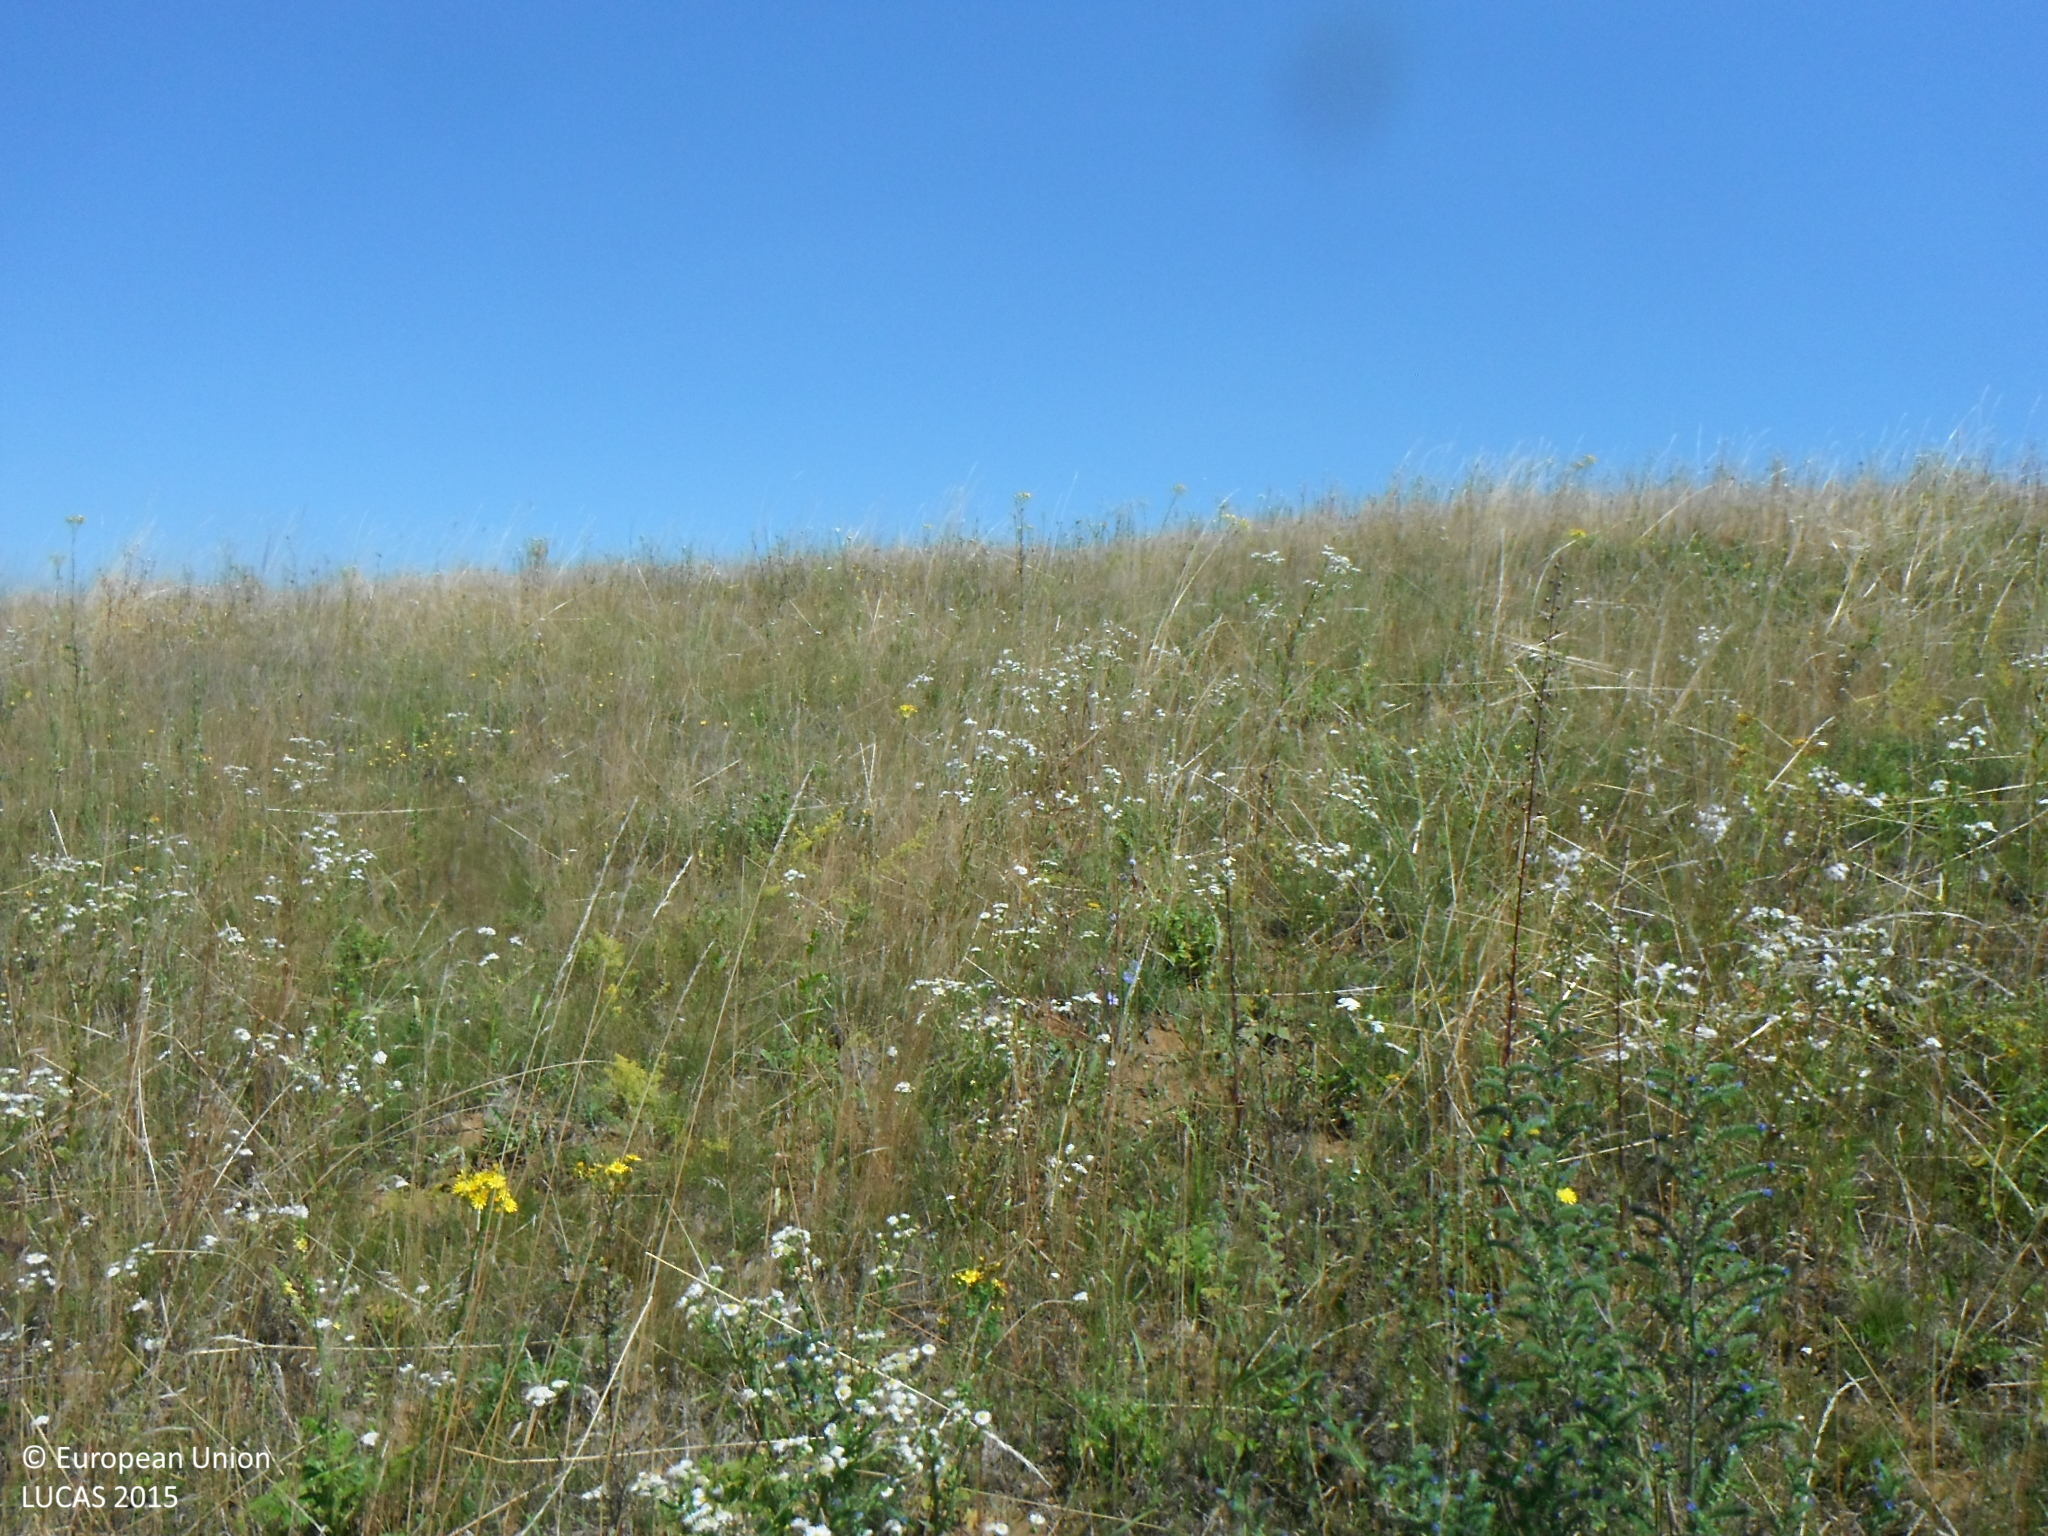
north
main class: Grassland
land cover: Spontaneously vegetated surfaces
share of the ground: > 75 %
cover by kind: herbaceous plants 100 %
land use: Fallow land
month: July
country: SK
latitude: 48.2134
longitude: 20.0827
